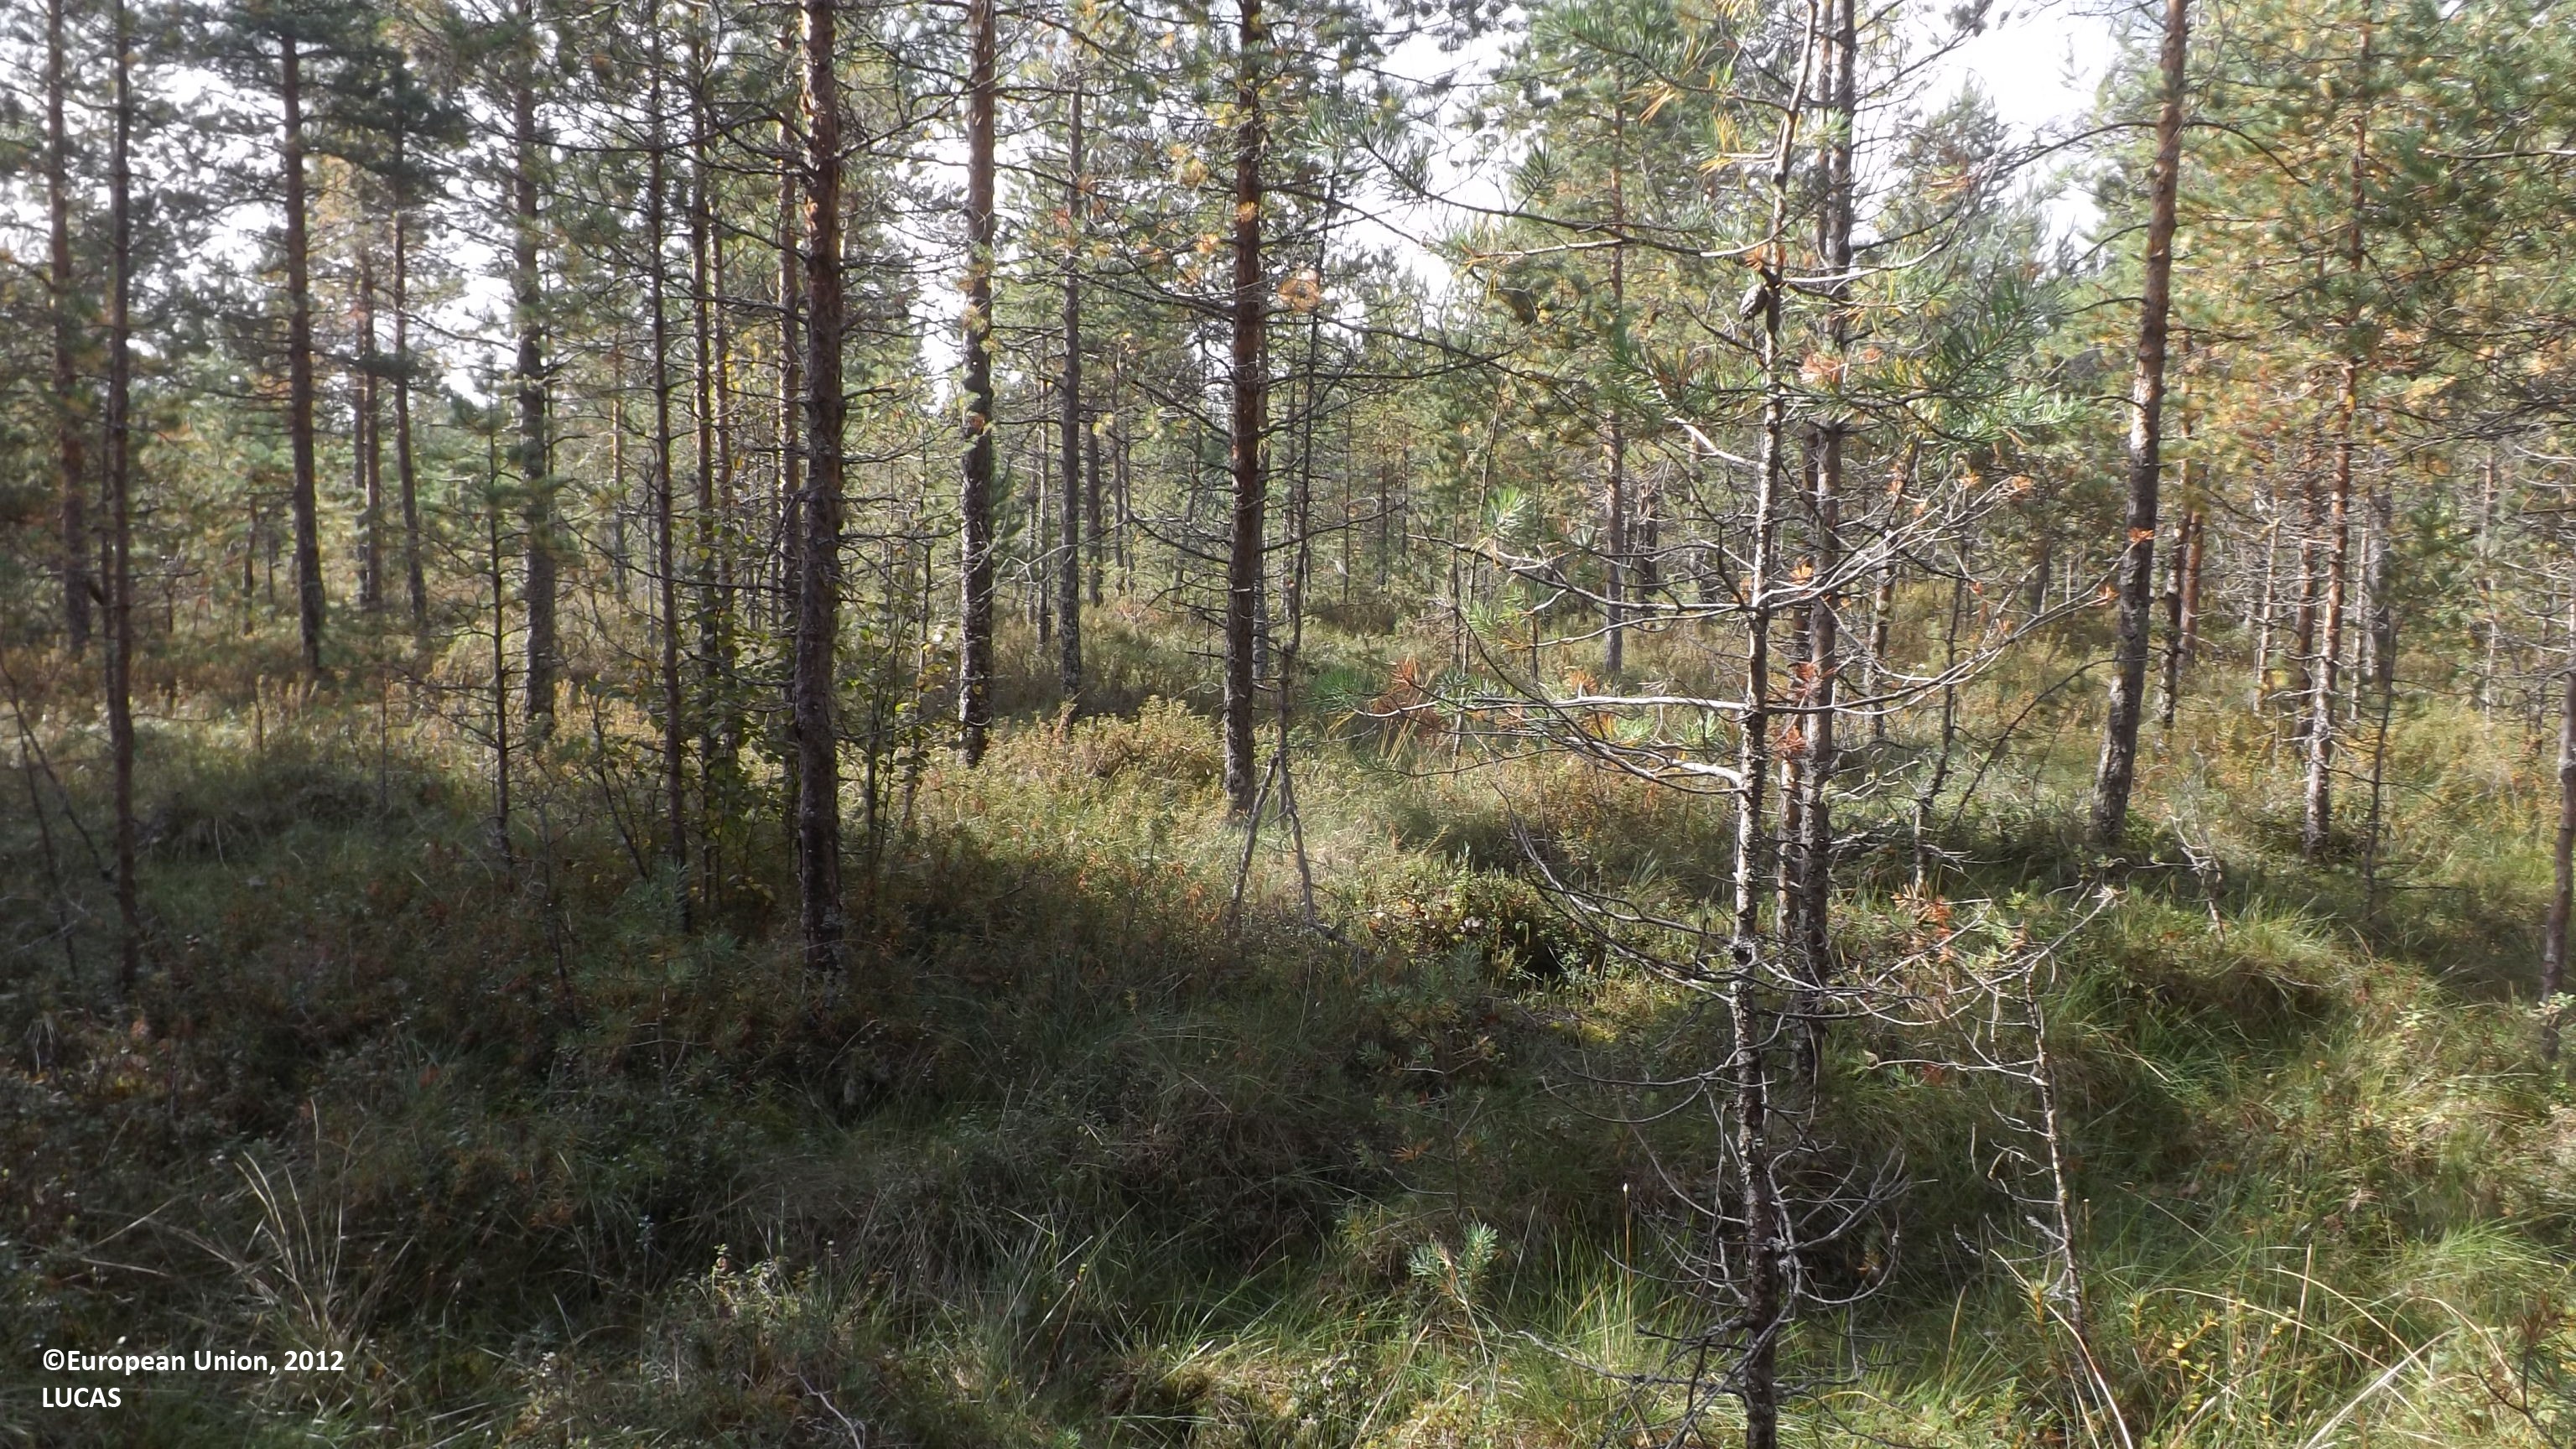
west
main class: Woodland
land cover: Pine dominated coniferous woodland
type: mire and swamp forests
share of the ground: 50 - 75 %
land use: Forestry
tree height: < 5 m
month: August
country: FI
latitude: 63.8935
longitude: 23.6876
